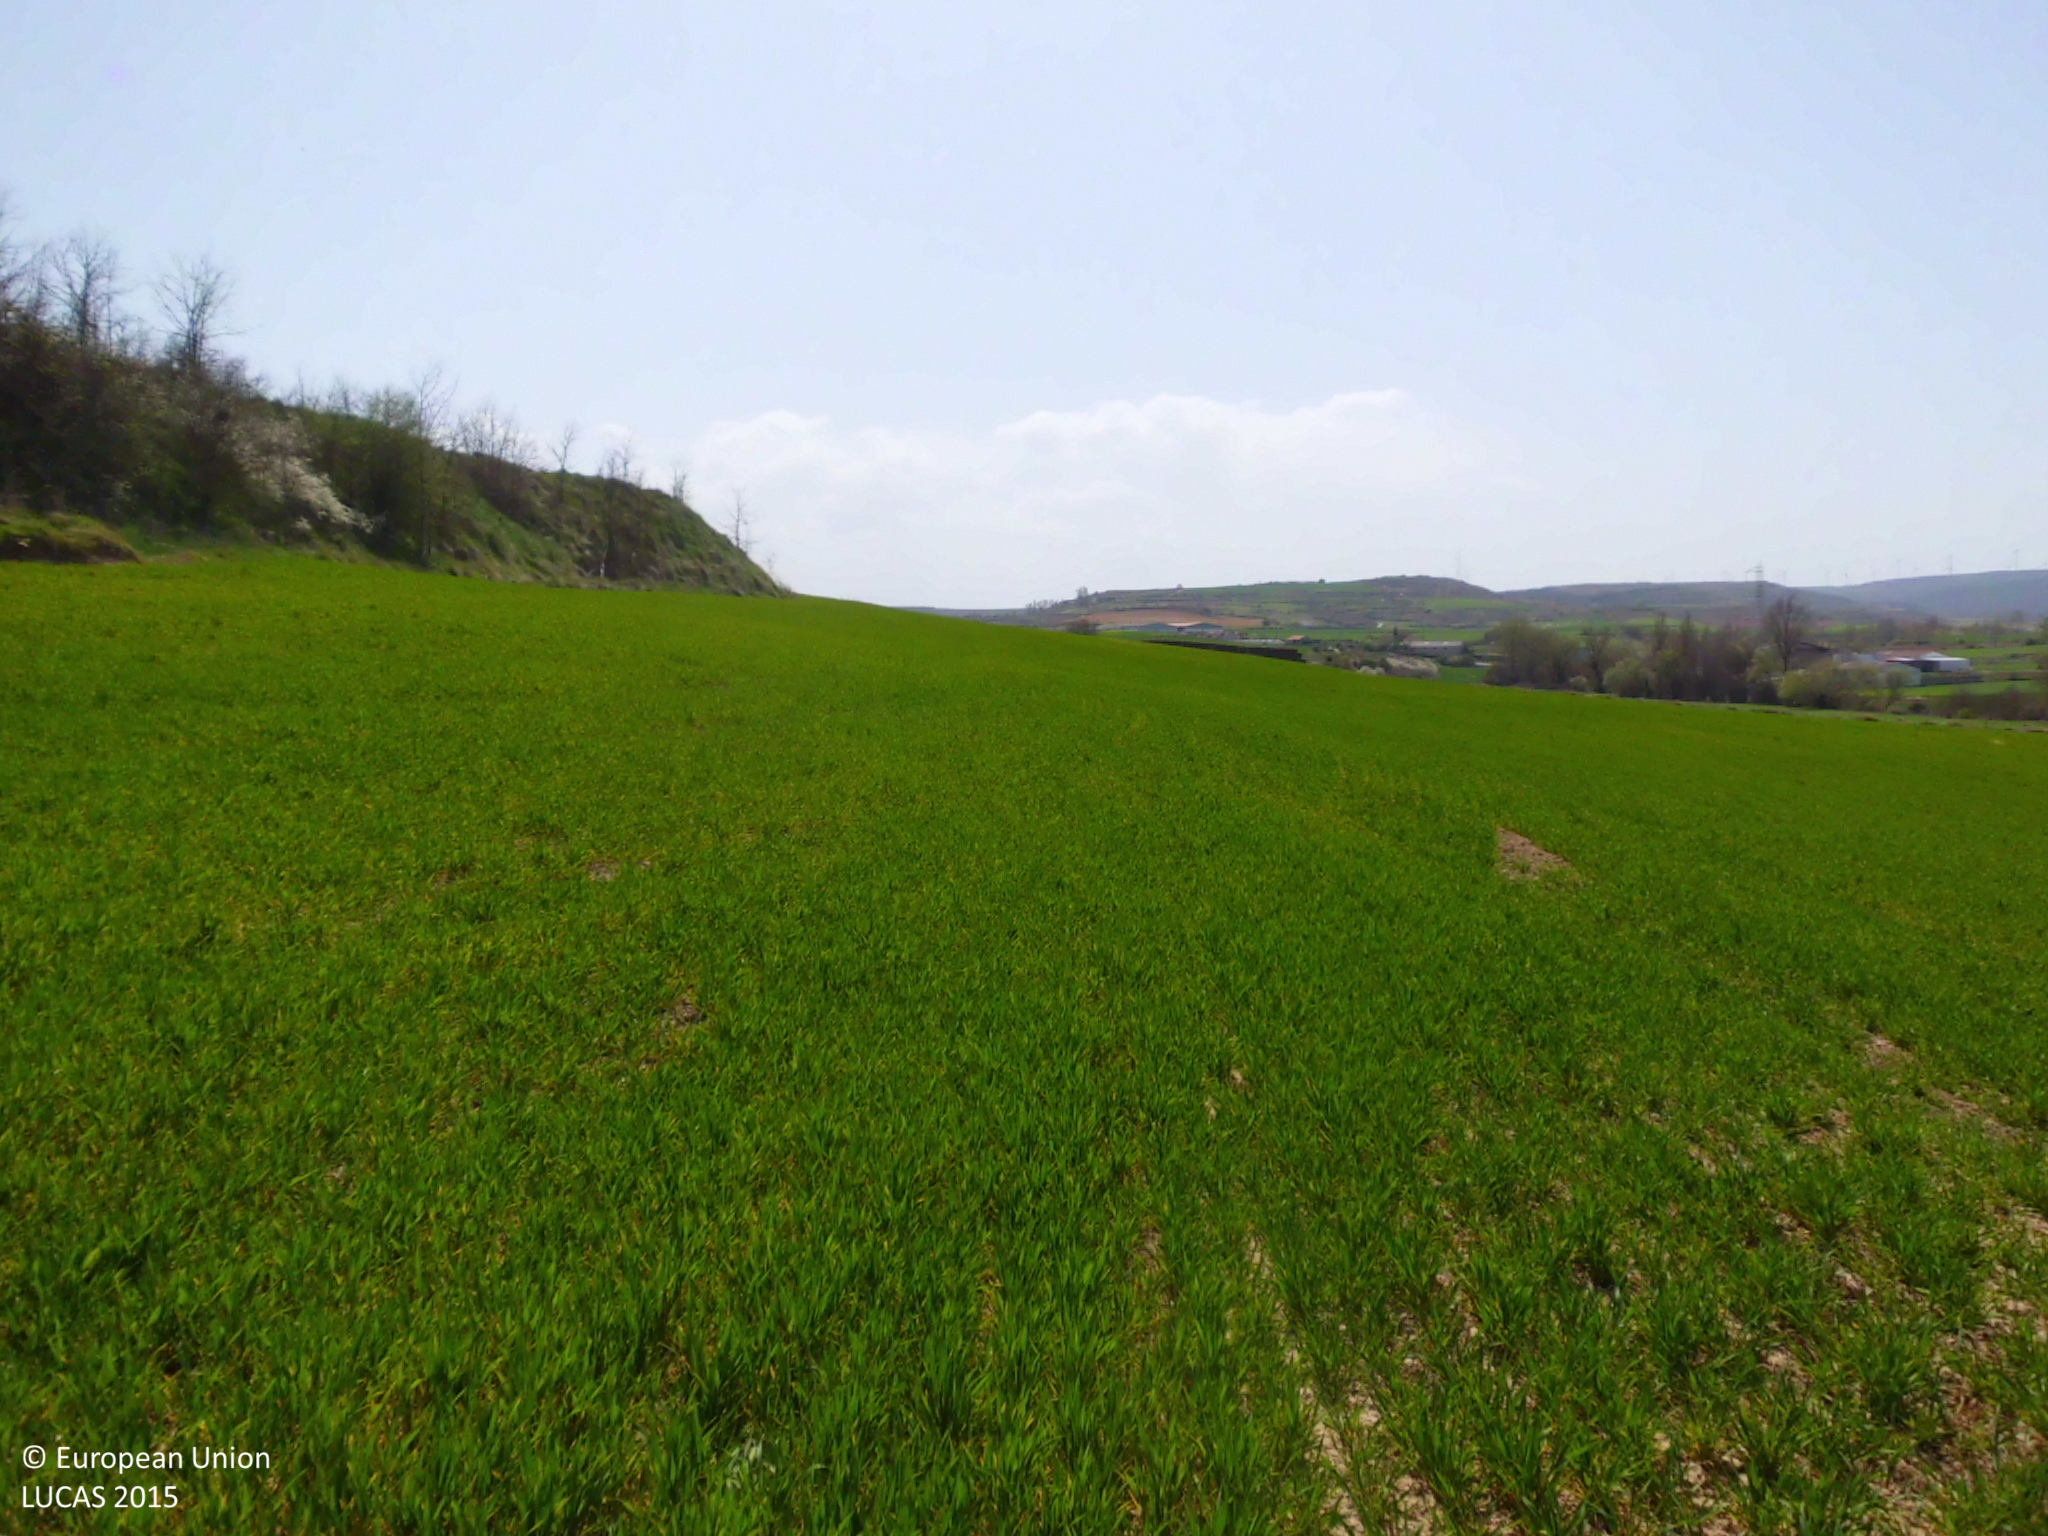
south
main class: Cropland
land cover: Barley
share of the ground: 50 - 75 %
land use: Agriculture (excluding fallow land and kitchen gardens)
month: April
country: ES
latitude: 42.5735
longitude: -3.3245
